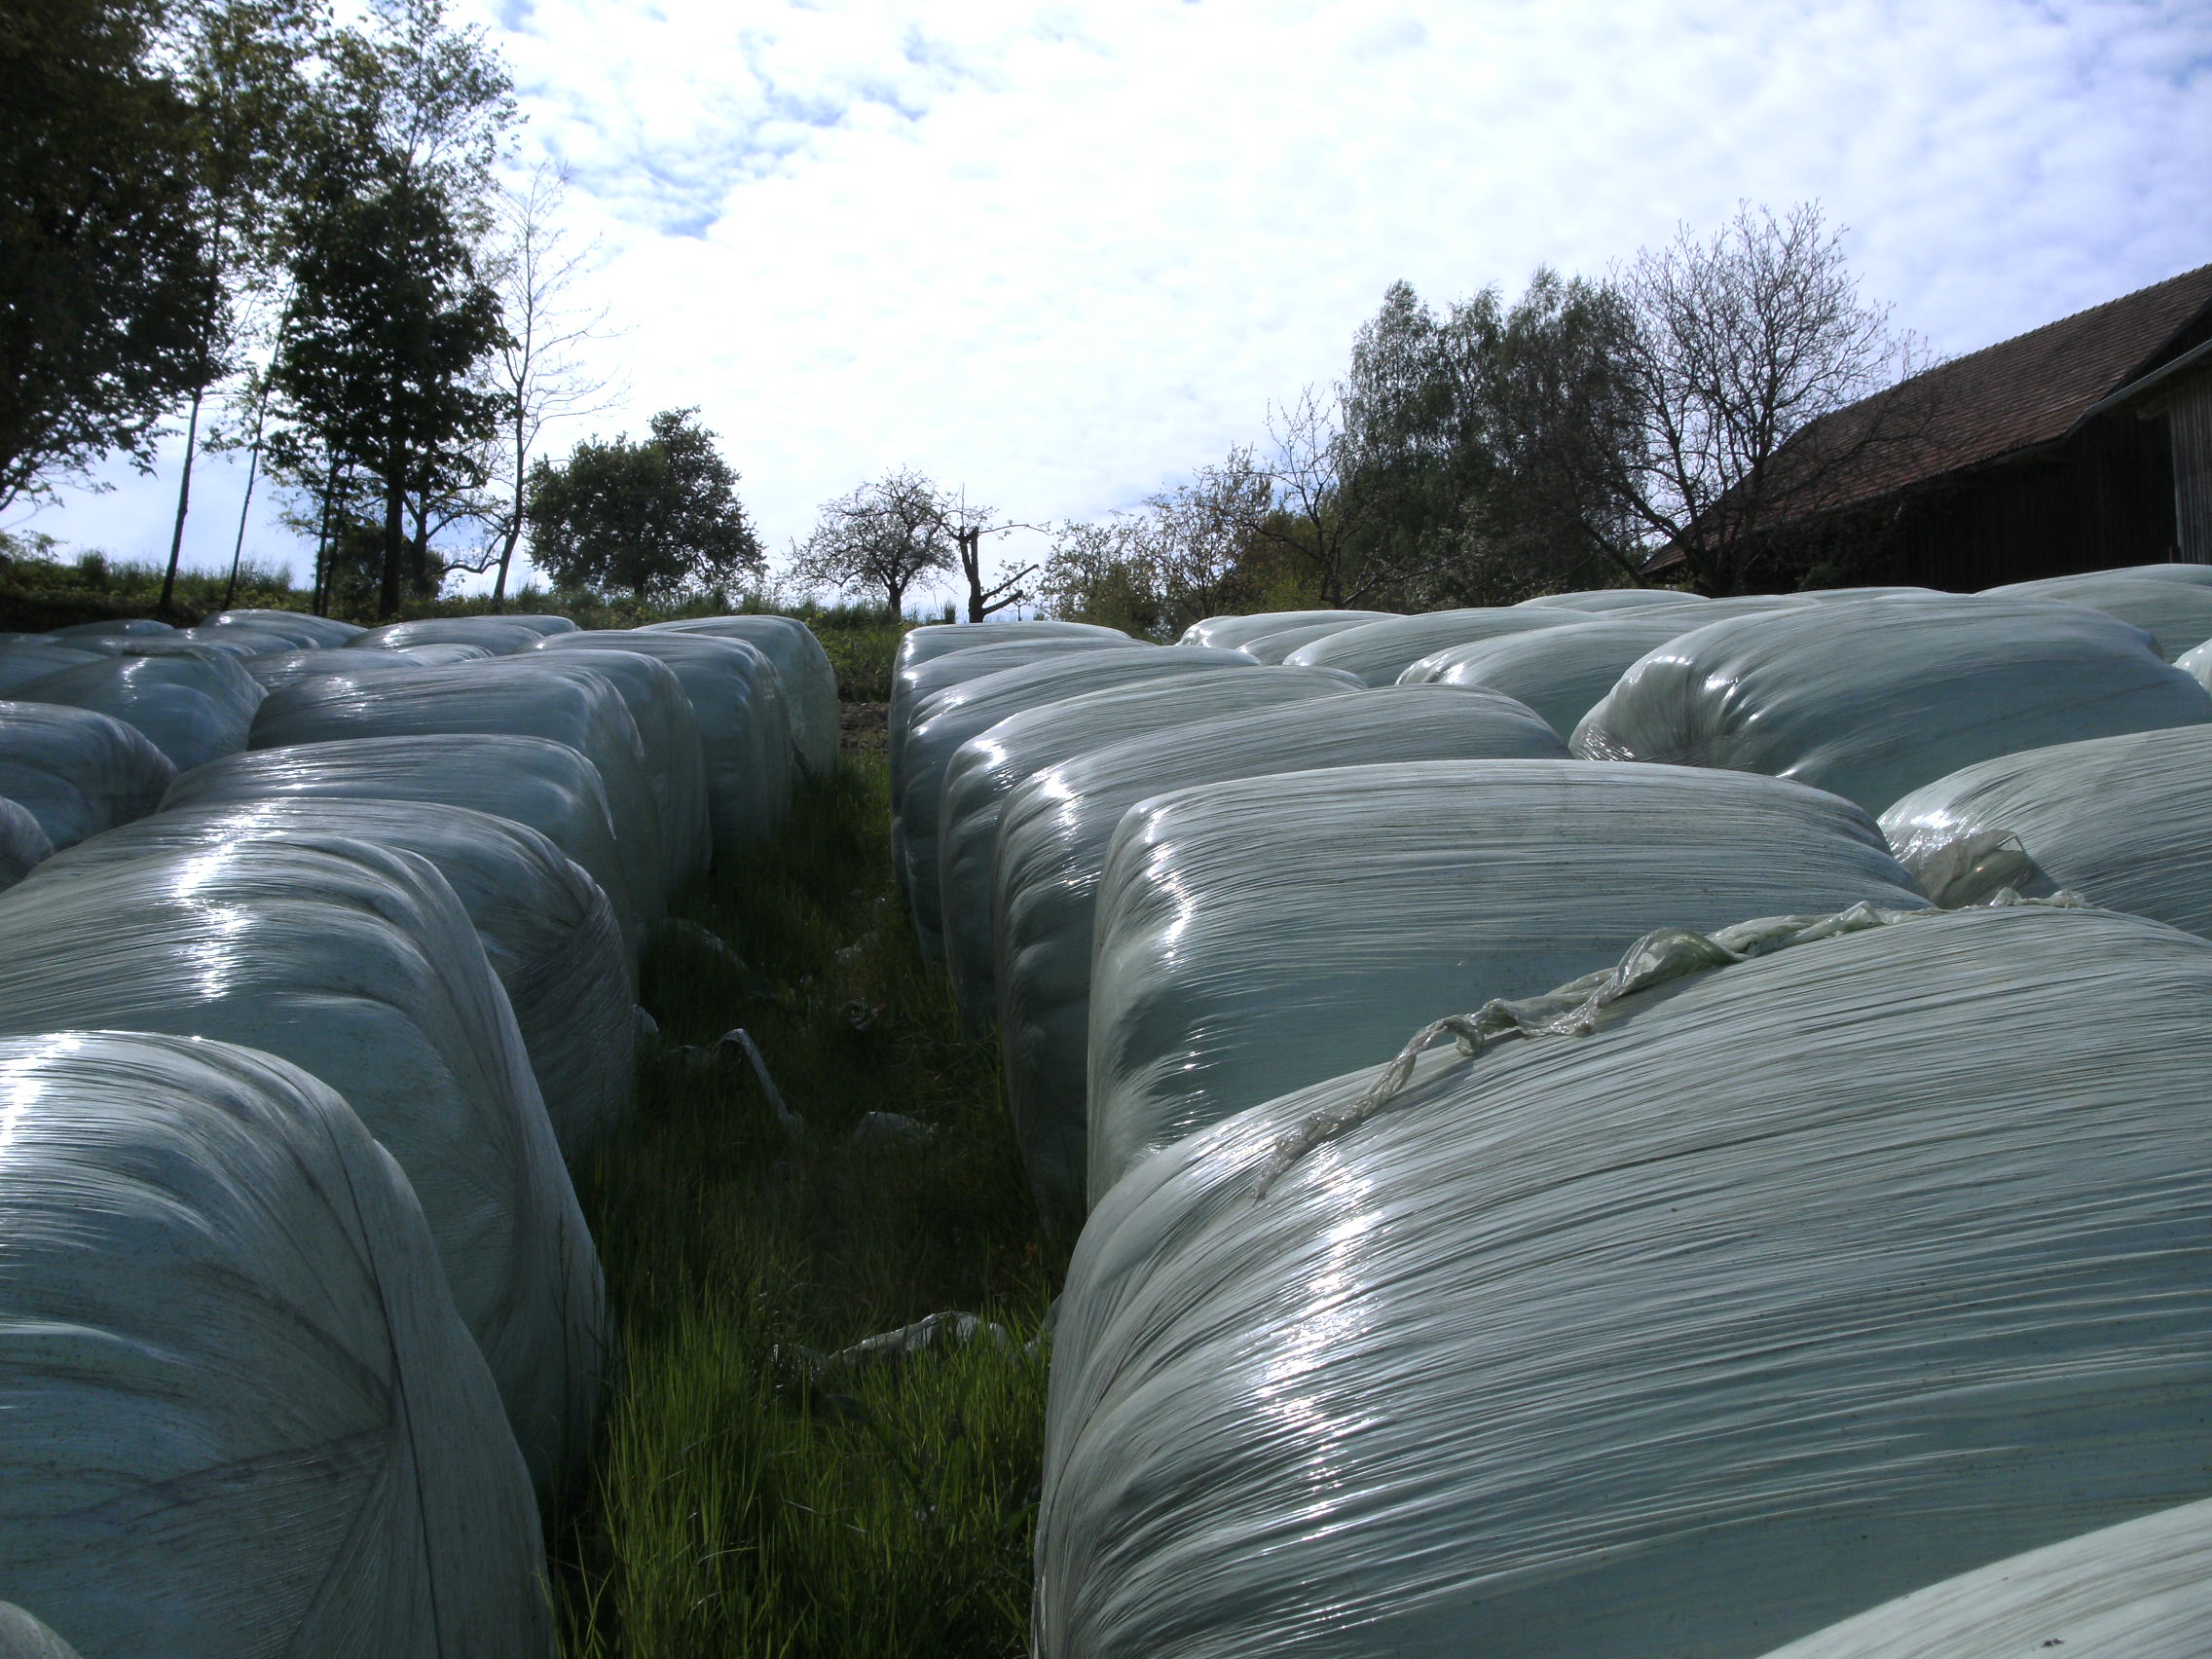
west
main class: Grassland
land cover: Spontaneously vegetated surfaces
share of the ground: 10 - 25 %
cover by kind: consolidated bare surface 30 %, herbaceous plants 15 %
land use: Agriculture (excluding fallow land and kitchen gardens)
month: May
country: AT
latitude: 48.5451
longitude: 13.5351
